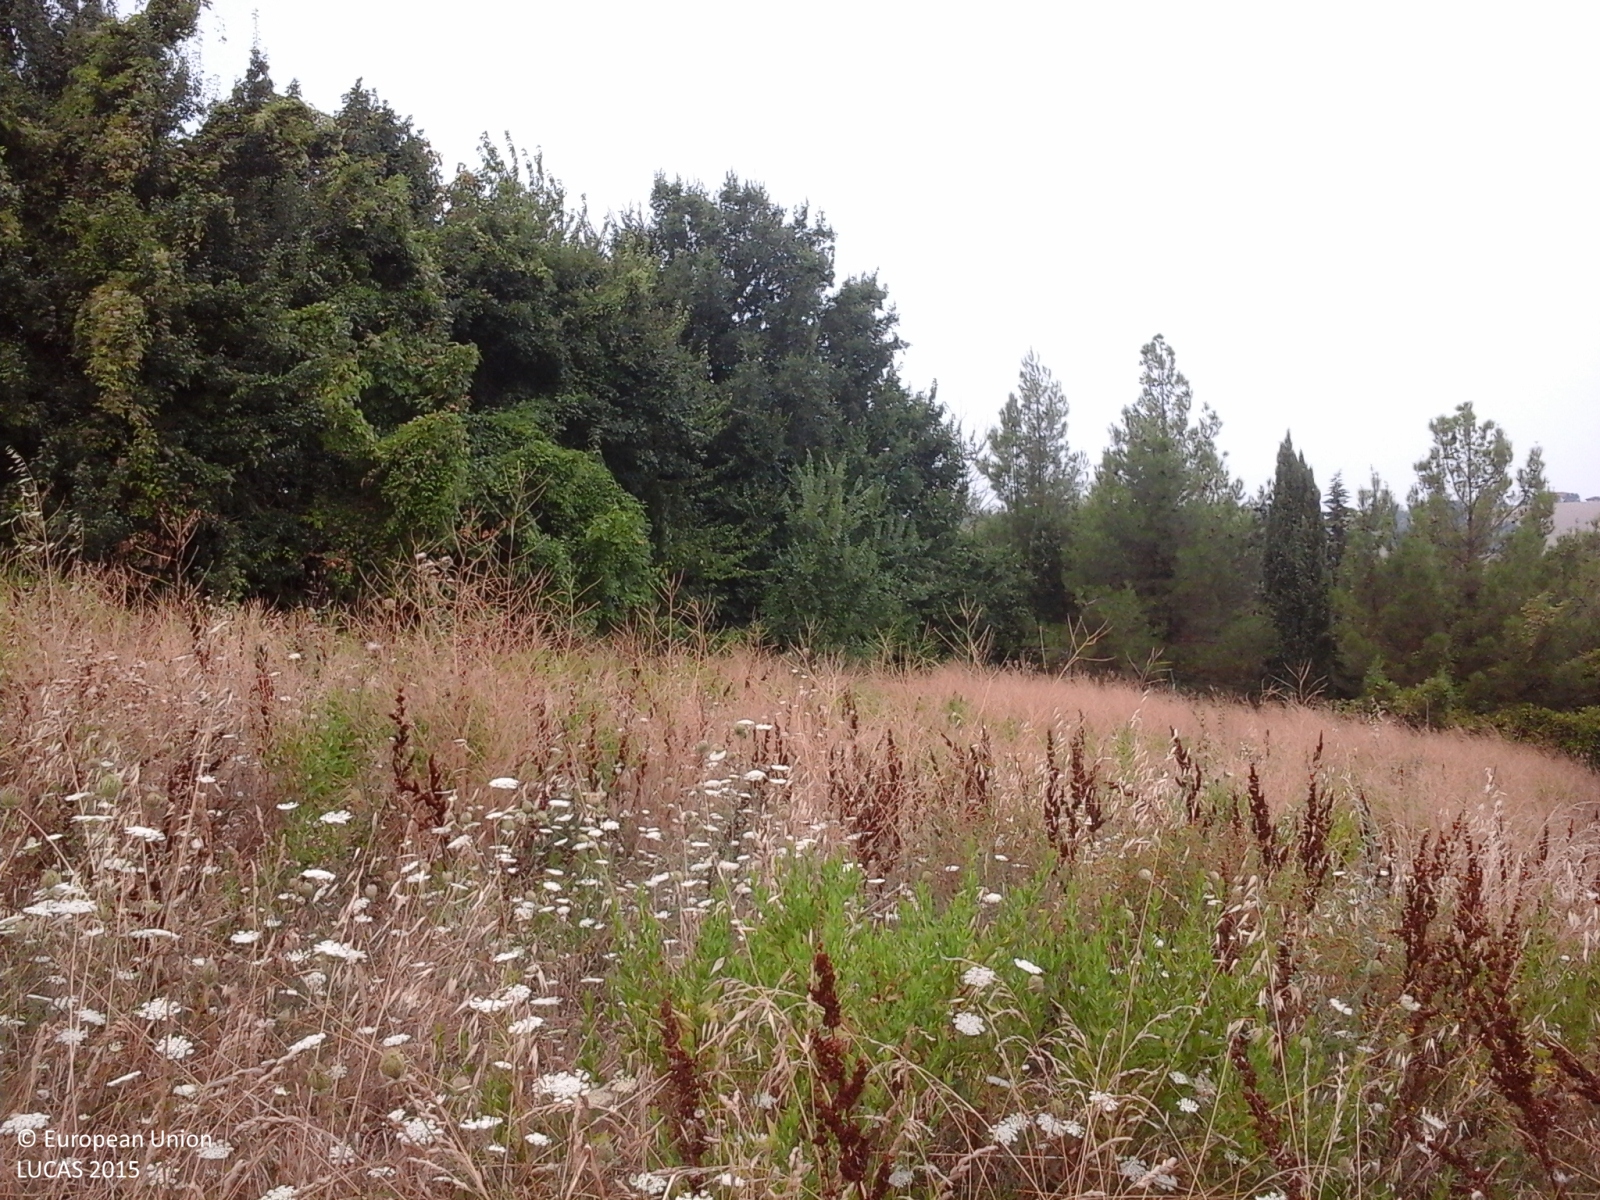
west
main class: Grassland
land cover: Spontaneously vegetated surfaces
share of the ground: > 75 %
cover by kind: herbaceous plants 95 %, shrubs 5 %
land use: Fallow land
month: August
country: IT
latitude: 43.4998
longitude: 13.4174
